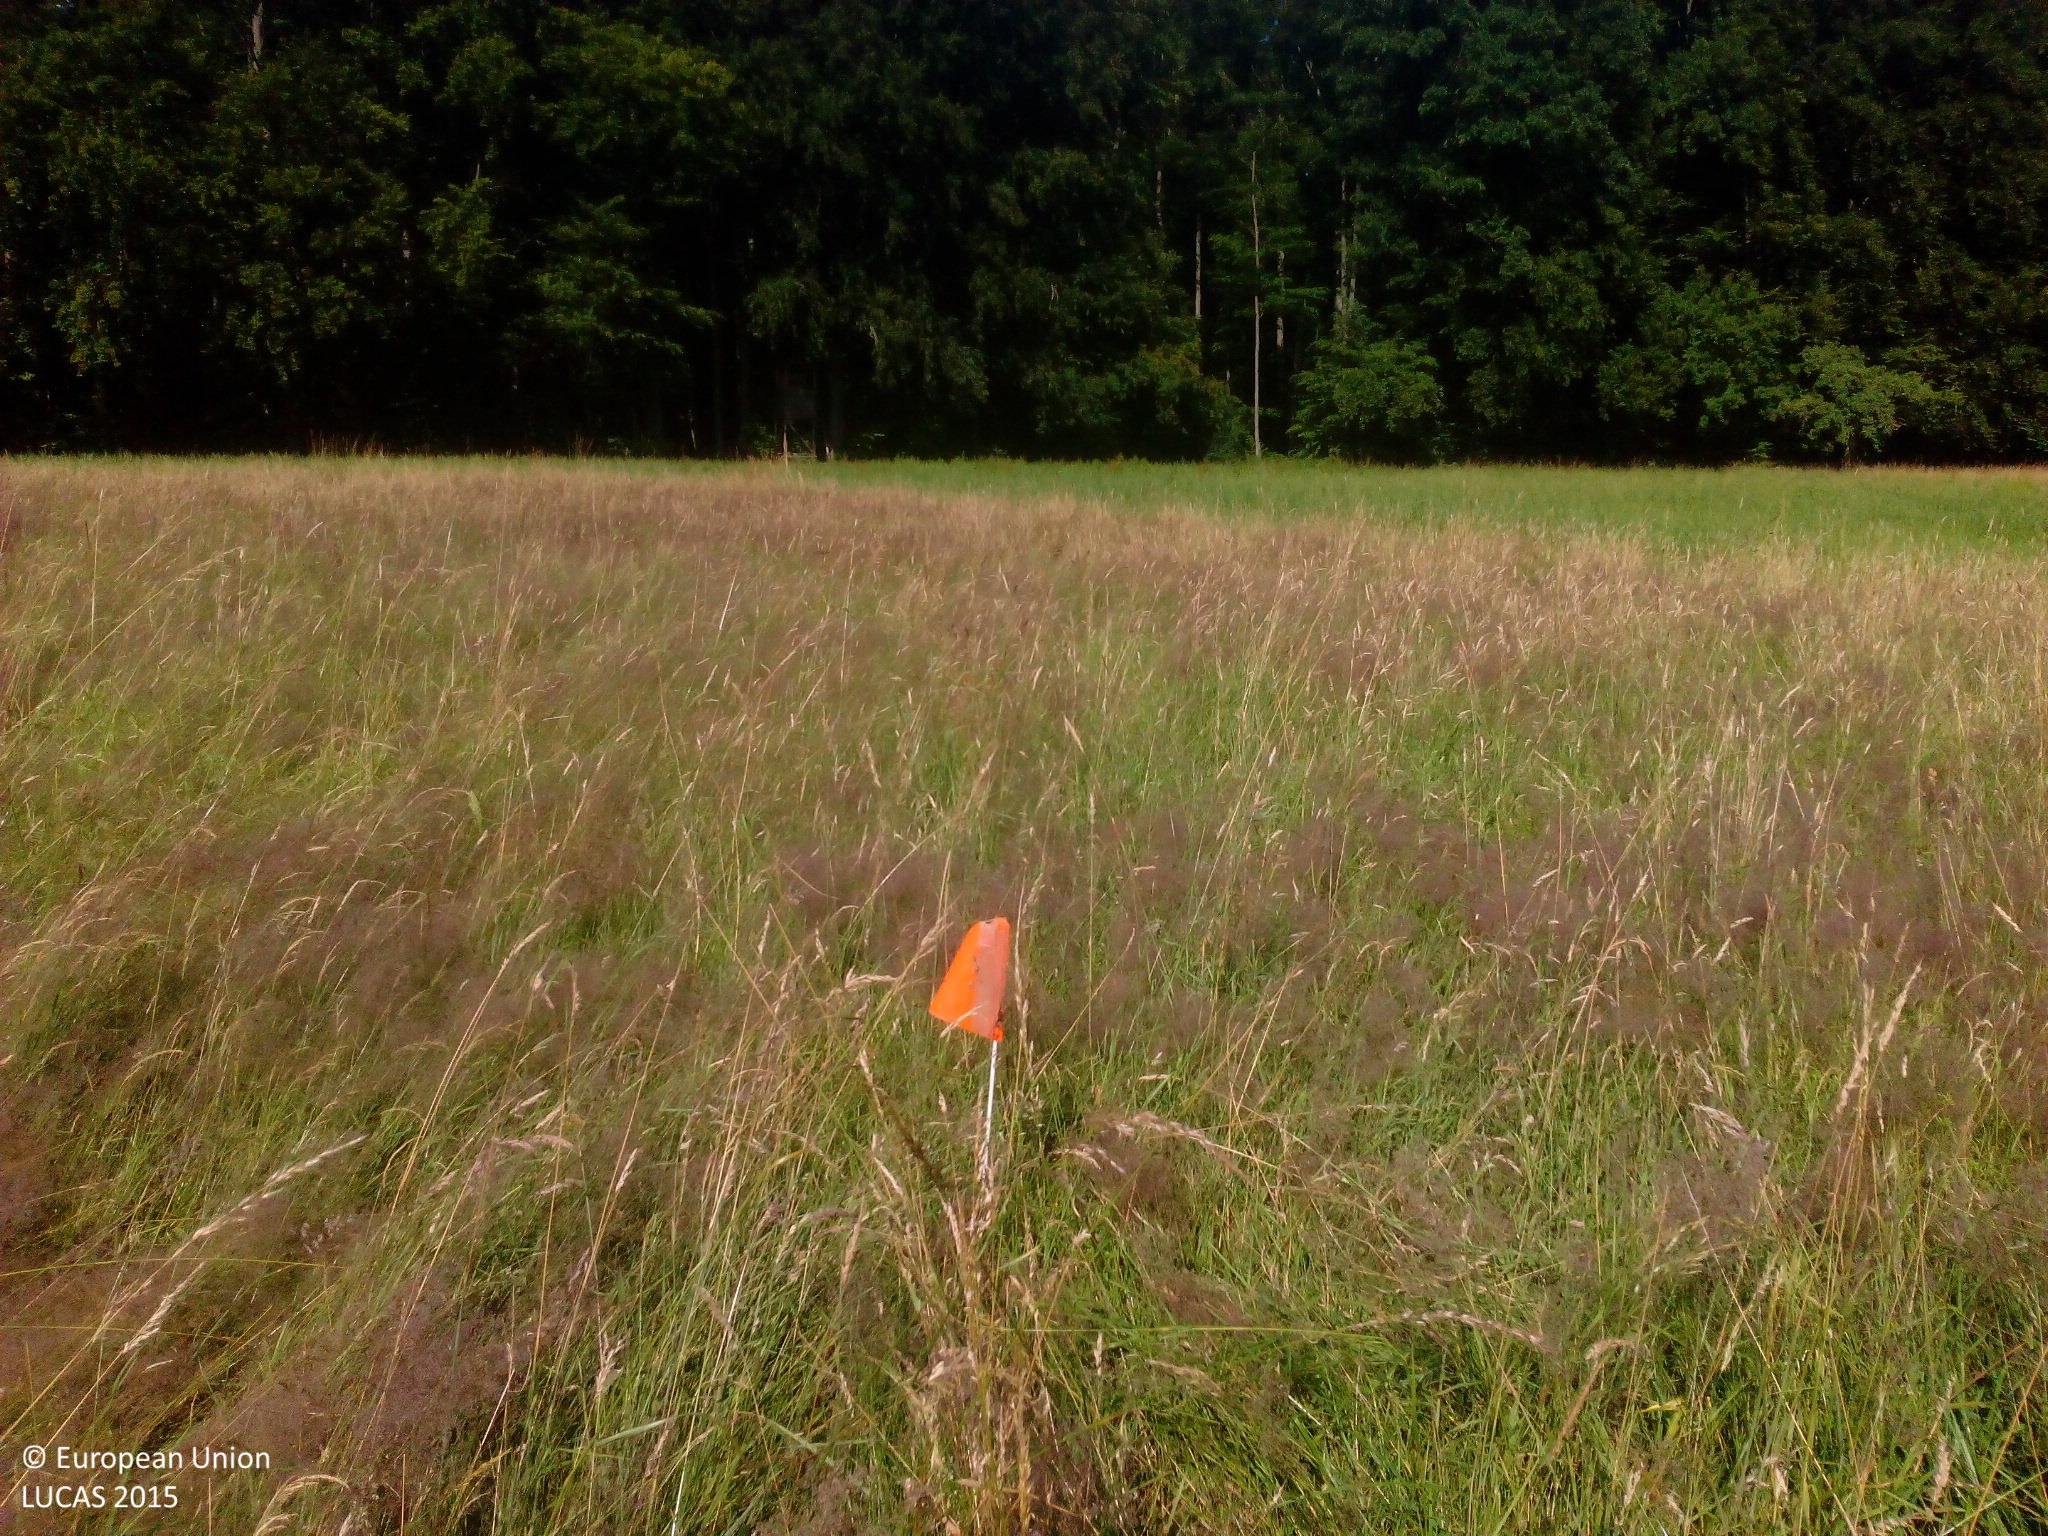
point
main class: Grassland
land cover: Grassland without tree/shrub cover
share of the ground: > 75 %
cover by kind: herbaceous plants 100 %
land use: Agriculture (excluding fallow land and kitchen gardens)
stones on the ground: < 10 %
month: June
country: DE
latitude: 48.5819
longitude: 9.4174
